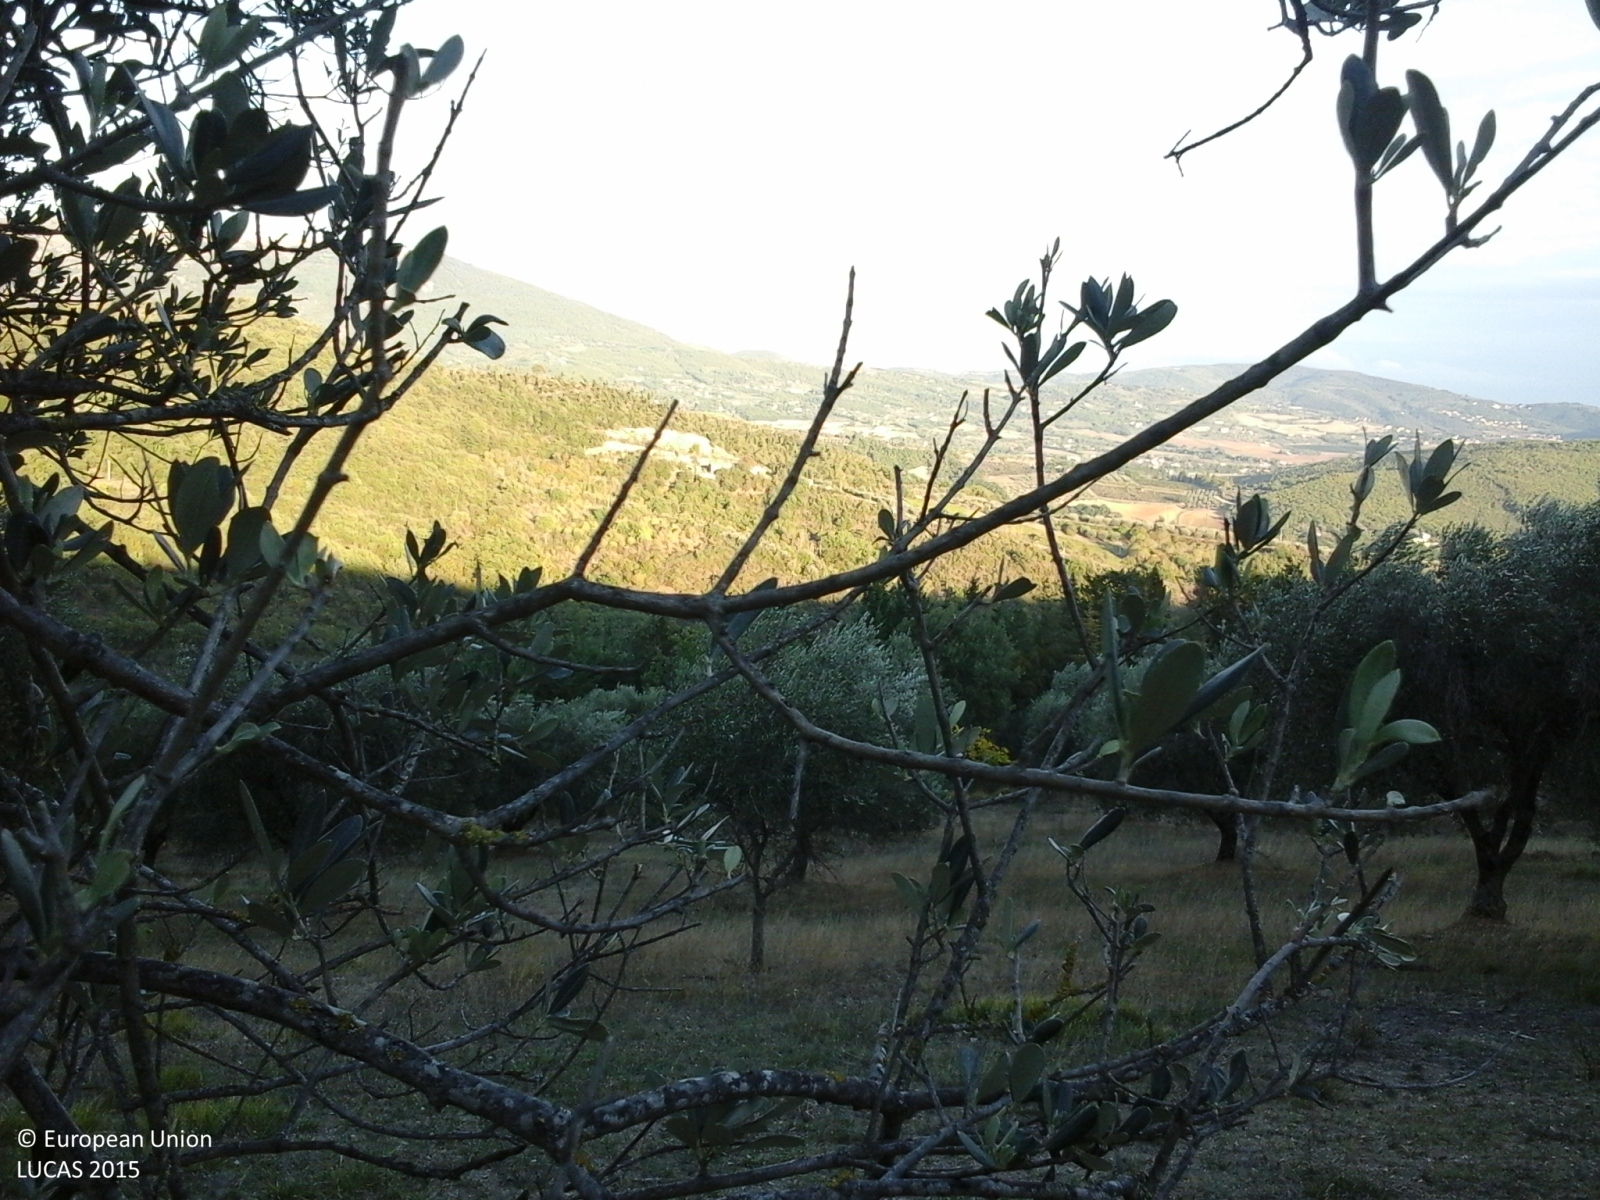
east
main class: Cropland
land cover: Olive groves
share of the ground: 25 - 50 %
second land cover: Spontaneously vegetated surfaces
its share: 50 - 75 %
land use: Agriculture (excluding fallow land and kitchen gardens)
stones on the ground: 10 - 25 %
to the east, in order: Olive groves; Spontaneously vegetated surfaces; Tracks; Olive groves; Tracks; Broadleaved woodland; Tracks; Broadleaved woodland
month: September
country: IT
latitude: 43.1885
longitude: 12.2698
